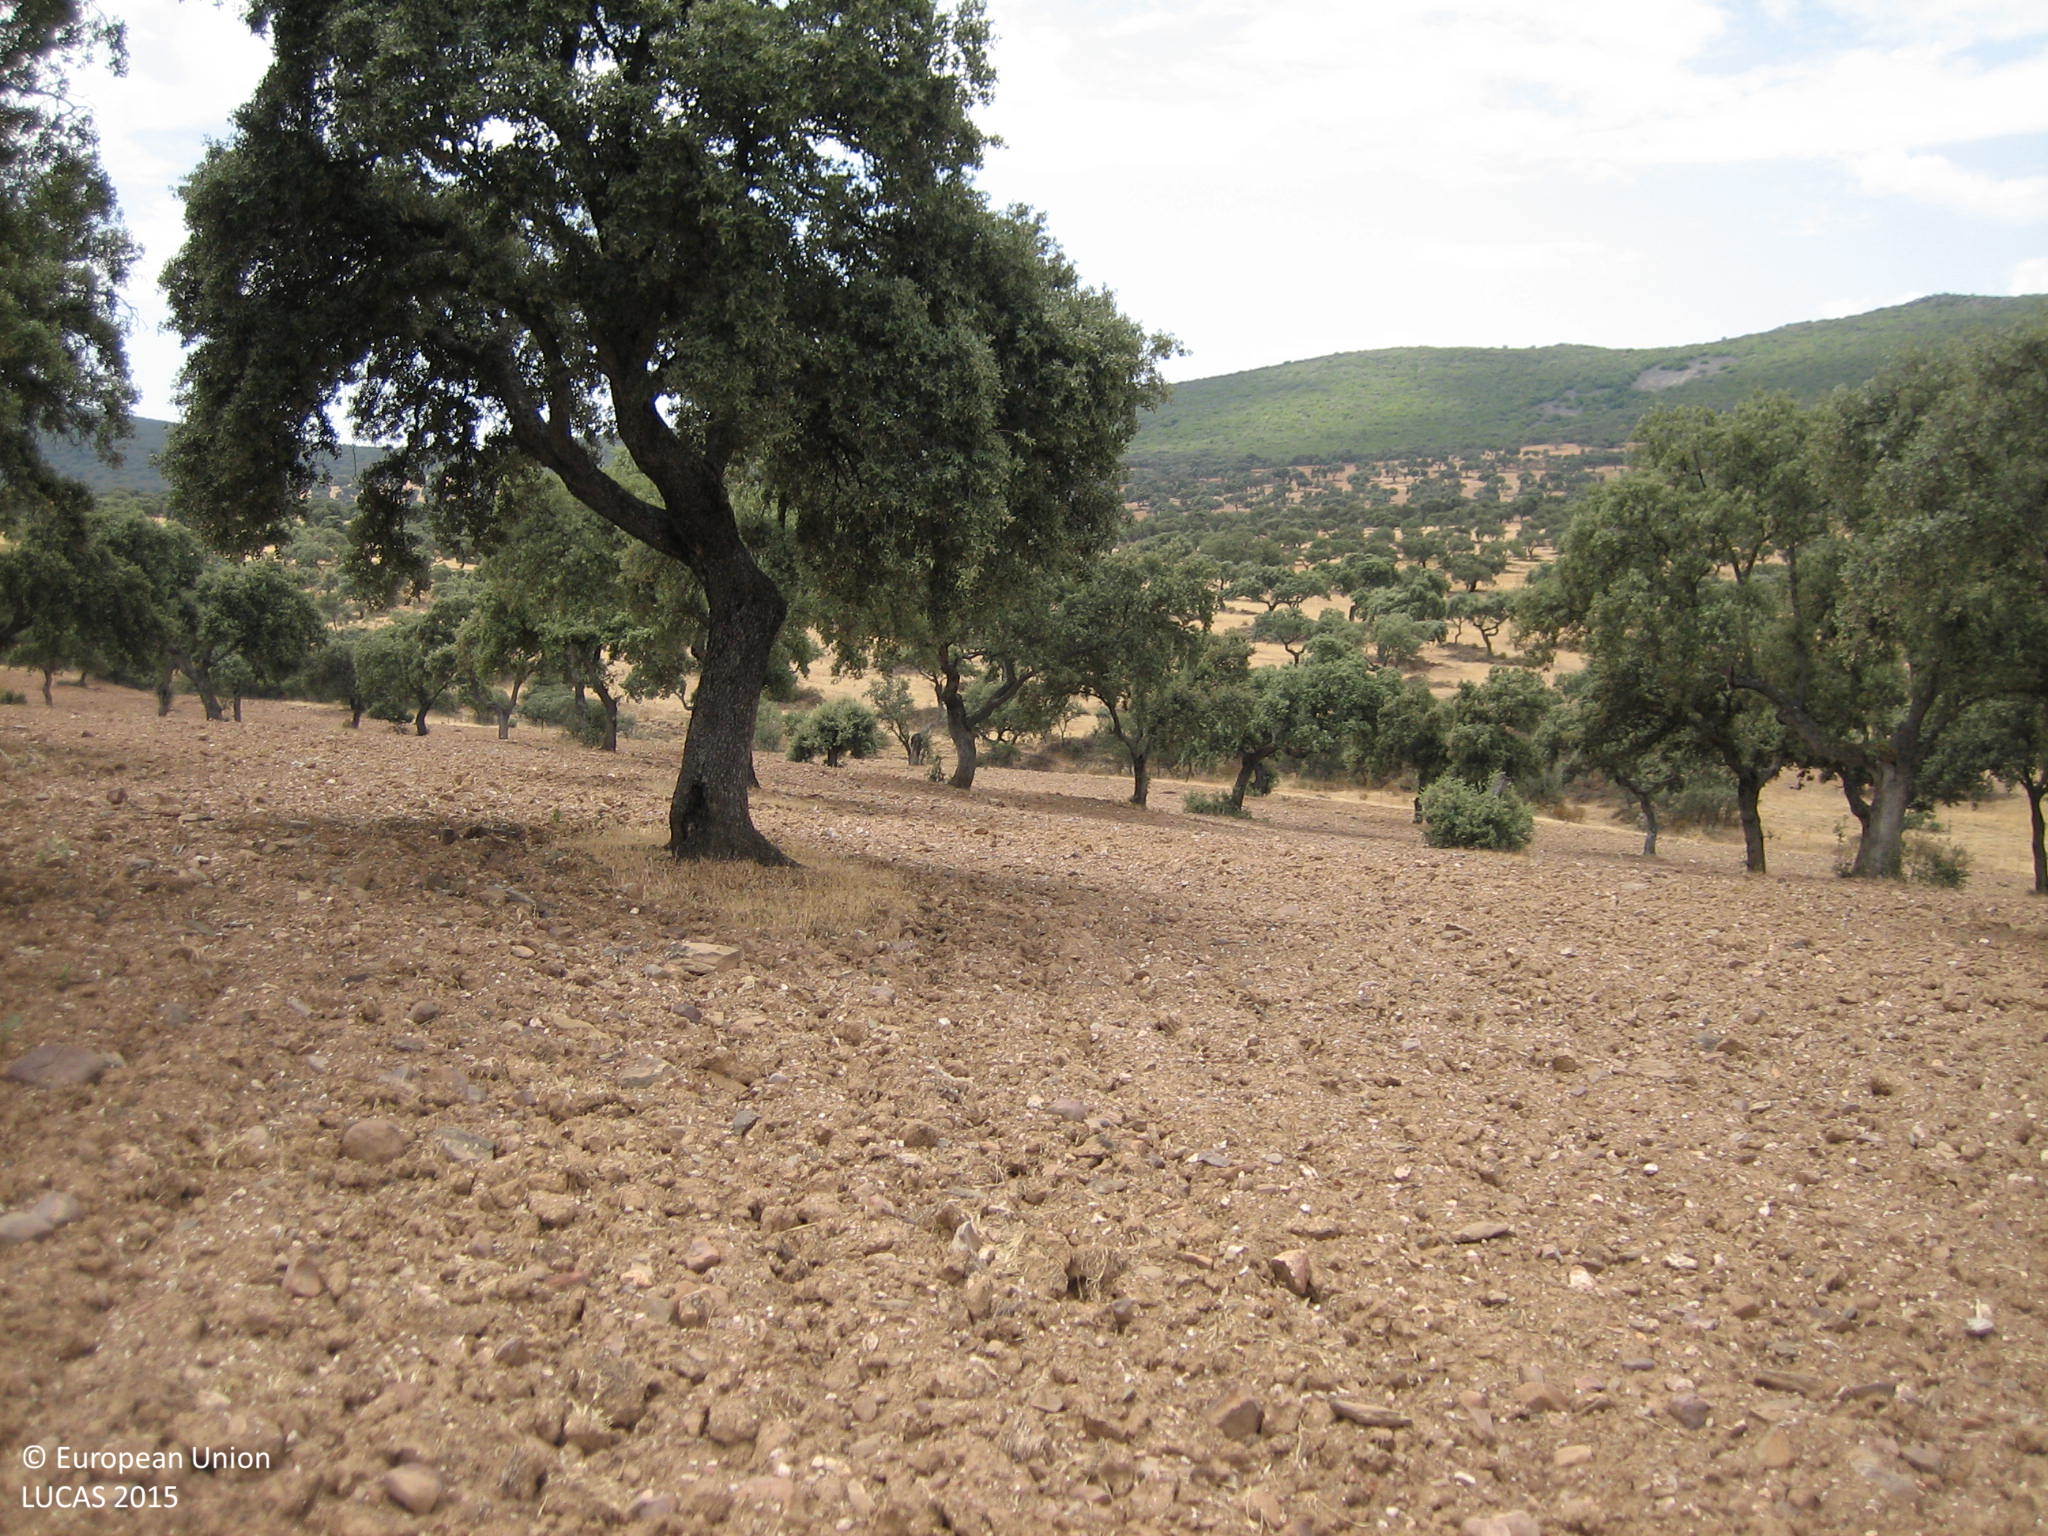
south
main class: Woodland
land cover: Broadleaved woodland
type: broadleaved evergreen forest
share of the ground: 10 - 25 %
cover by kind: unconsolidated bare surface 90 %, broadleaved forest trees 10 %
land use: Forestry
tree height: > 5 m
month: July
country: ES
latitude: 38.4798
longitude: -5.3591
